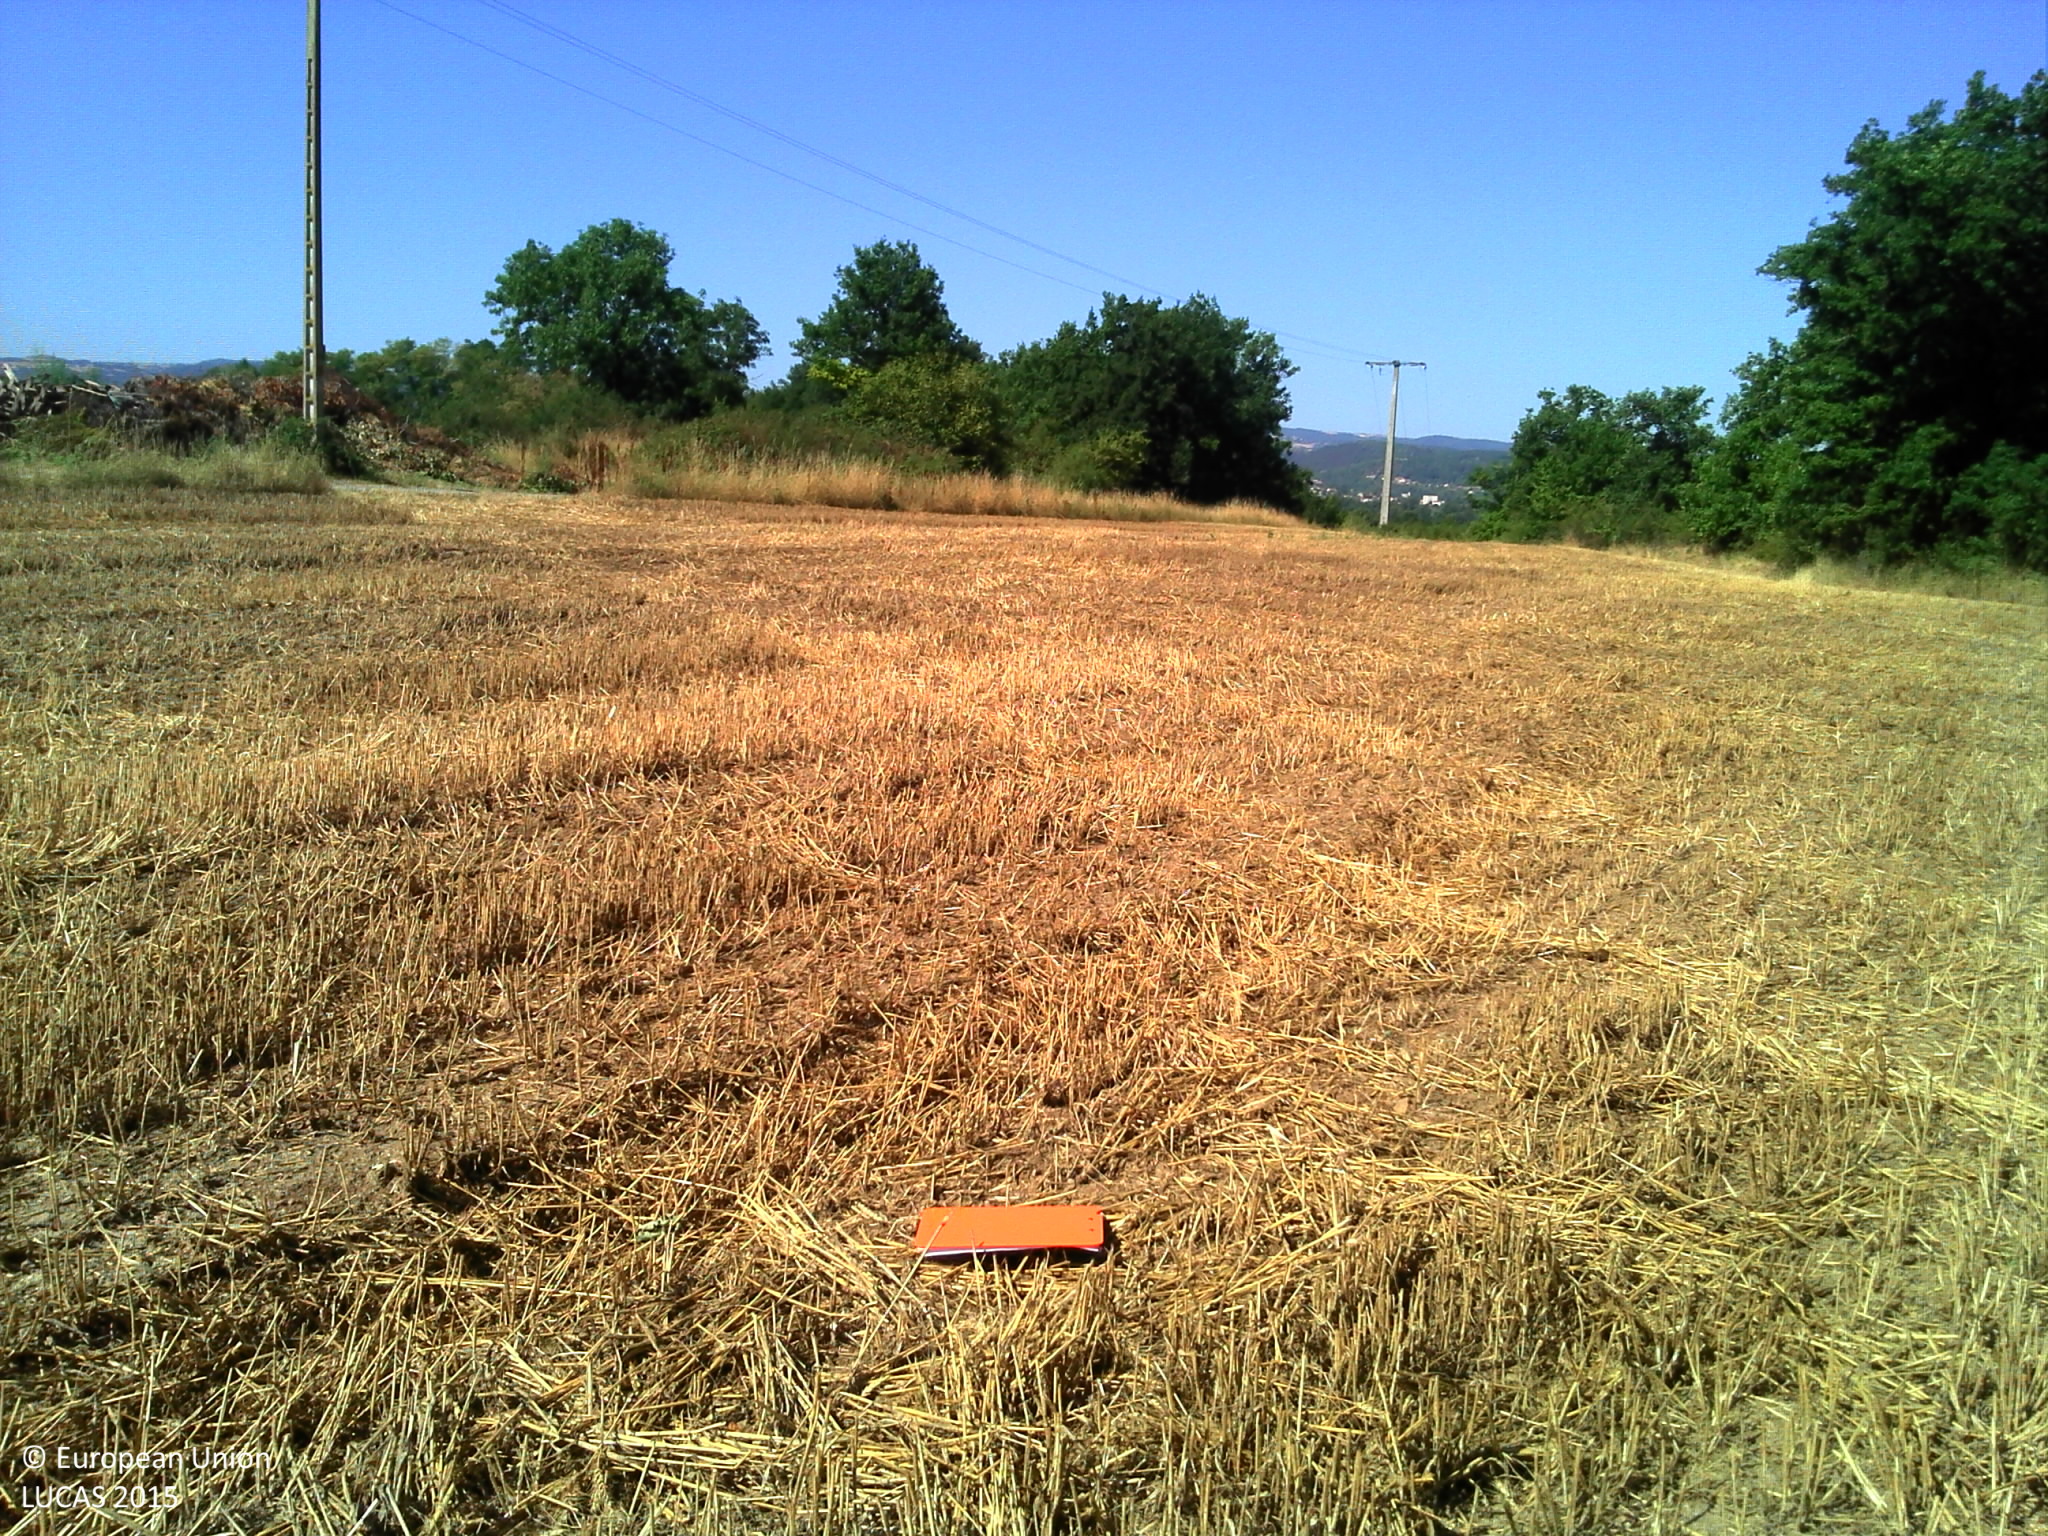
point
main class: Cropland
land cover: Barley
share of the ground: > 75 %
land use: Agriculture (excluding fallow land and kitchen gardens)
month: July
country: FR
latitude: 45.3000
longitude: 3.4347
